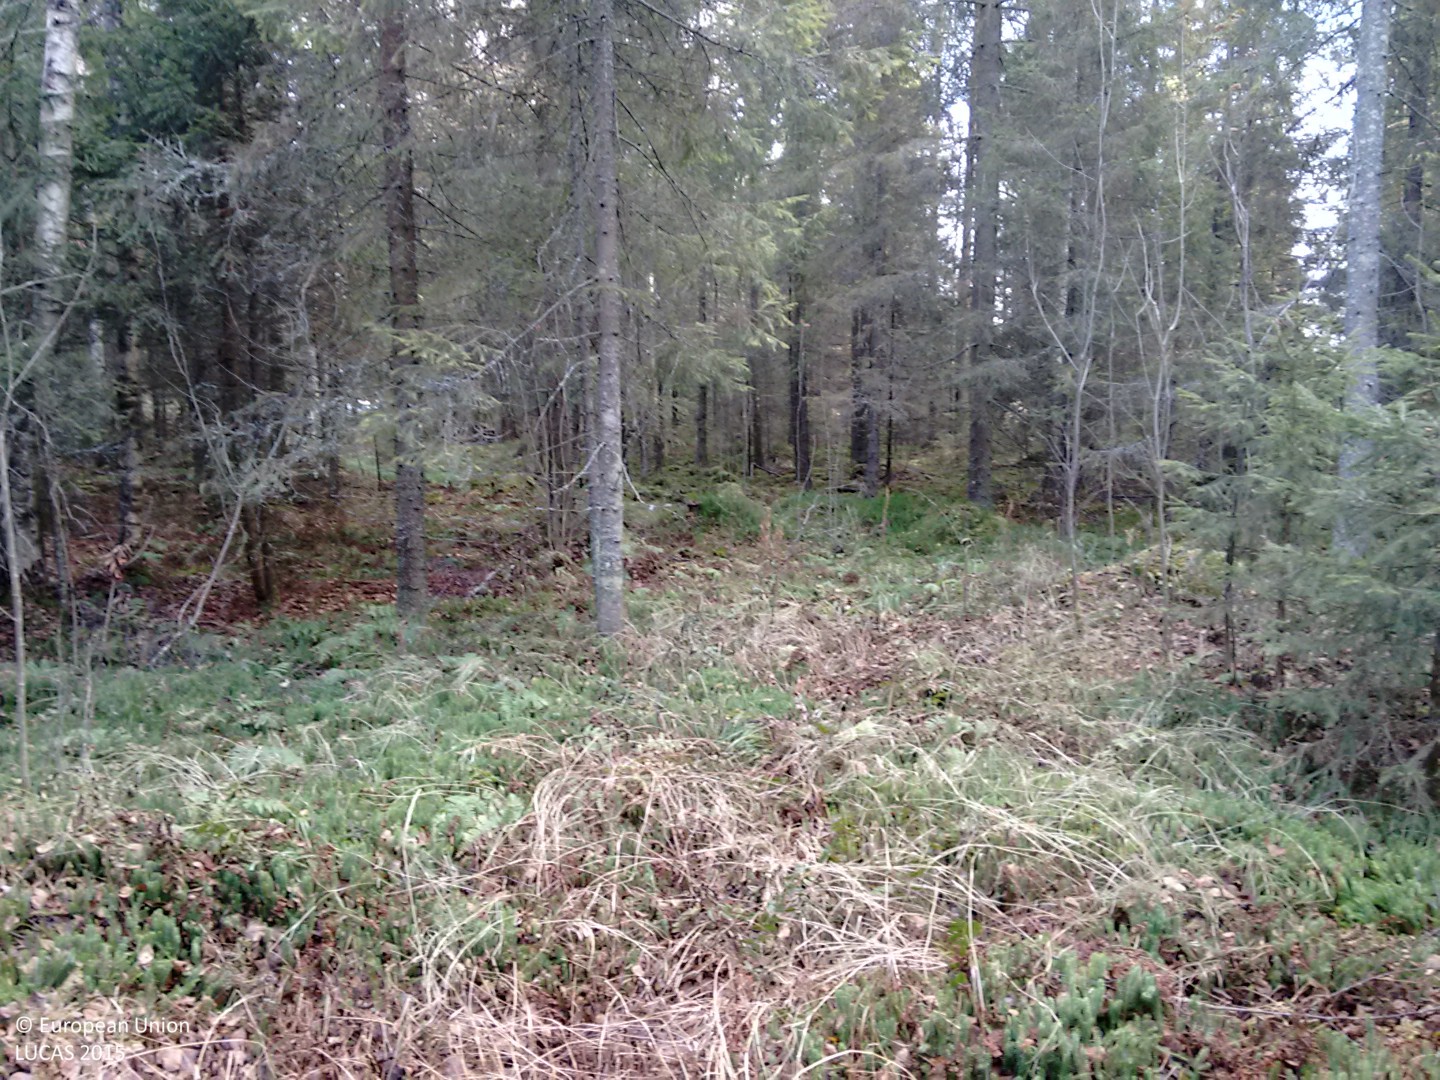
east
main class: Woodland
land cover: Spruce dominated mixed woodland
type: boreal forest
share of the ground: > 75 %
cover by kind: coniferous forest trees 60 %, broadleaved forest trees 25 %, herbaceous plants 10 %, shrubs 5 %
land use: Forestry
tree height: > 5 m
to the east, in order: Spruce dominated mixed woodland; Ditches and canals; Shruby margins; Temporary grasslands; Ditches and canals; Temporary grasslands; Ditches and canals; Temporary grasslands; Ditches and canals; Temporary grasslands
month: October
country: FI
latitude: 63.9186
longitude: 25.1964
